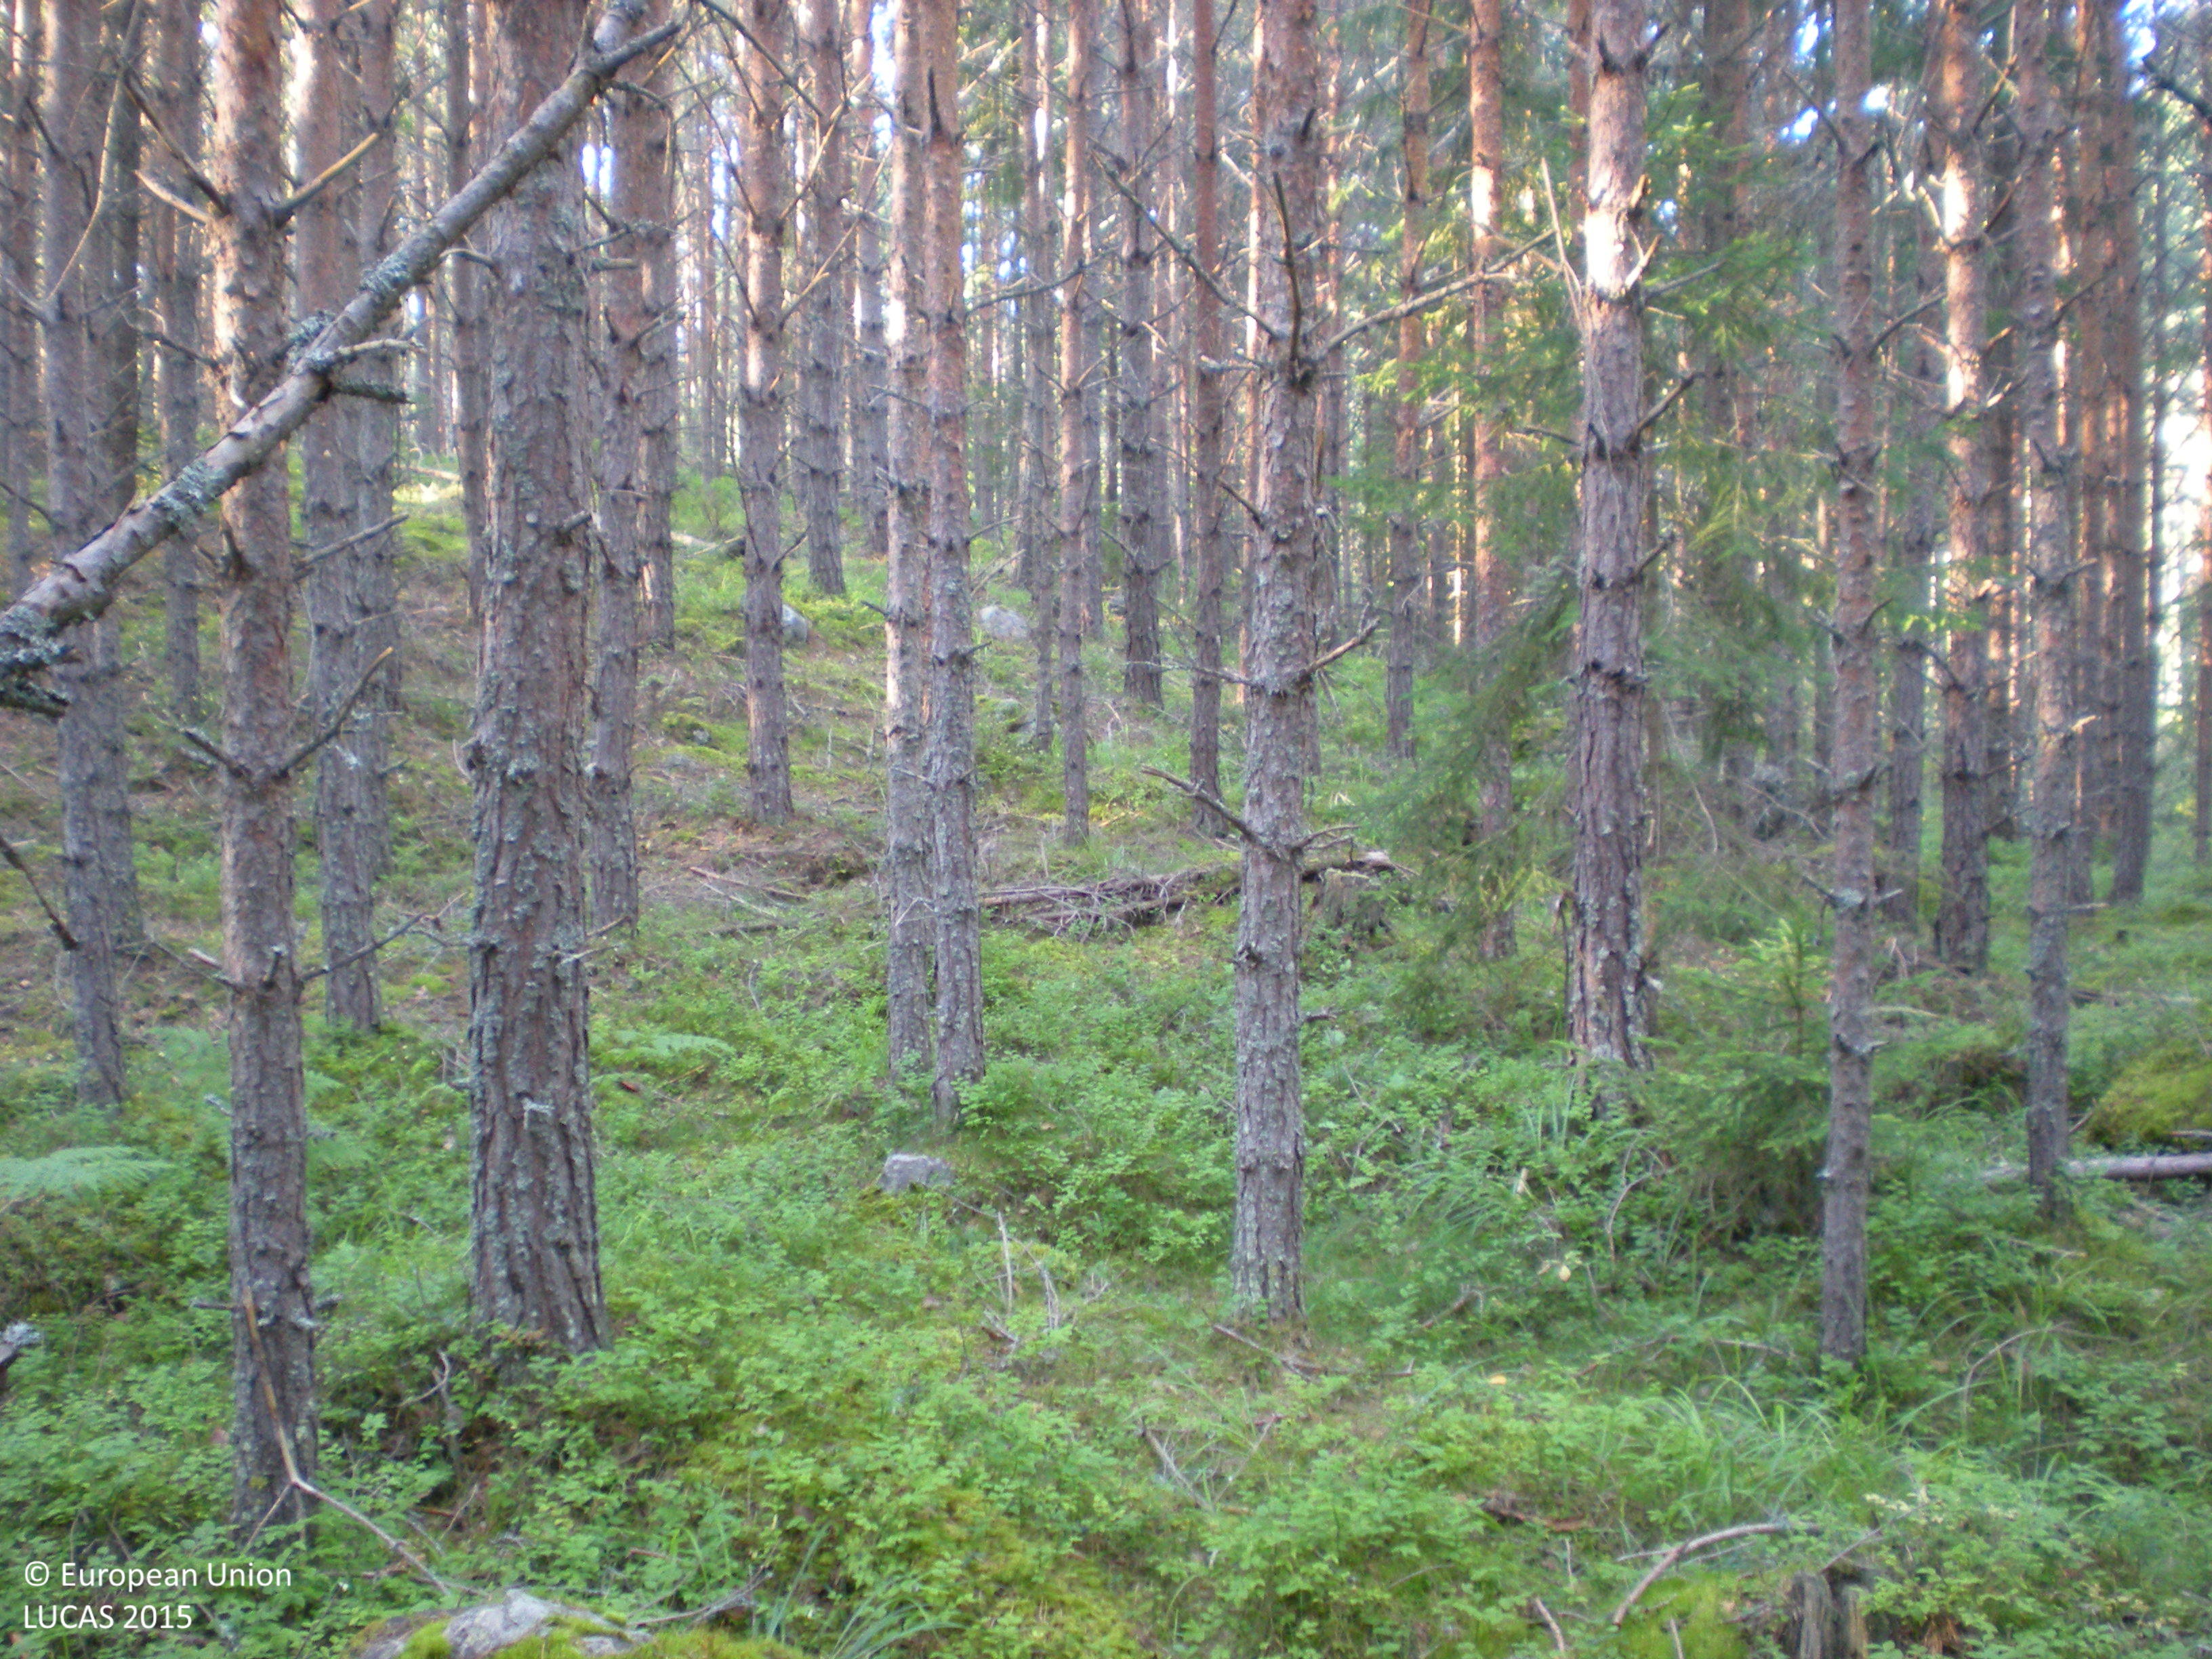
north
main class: Woodland
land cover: Pine dominated coniferous woodland
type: boreal forest
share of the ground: > 75 %
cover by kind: coniferous forest trees 85 %, shrubs 5 %, herbaceous plants 5 %, lichens and mosses 5 %
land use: Forestry
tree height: > 5 m
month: August
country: SE
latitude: 60.6830
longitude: 16.8542
